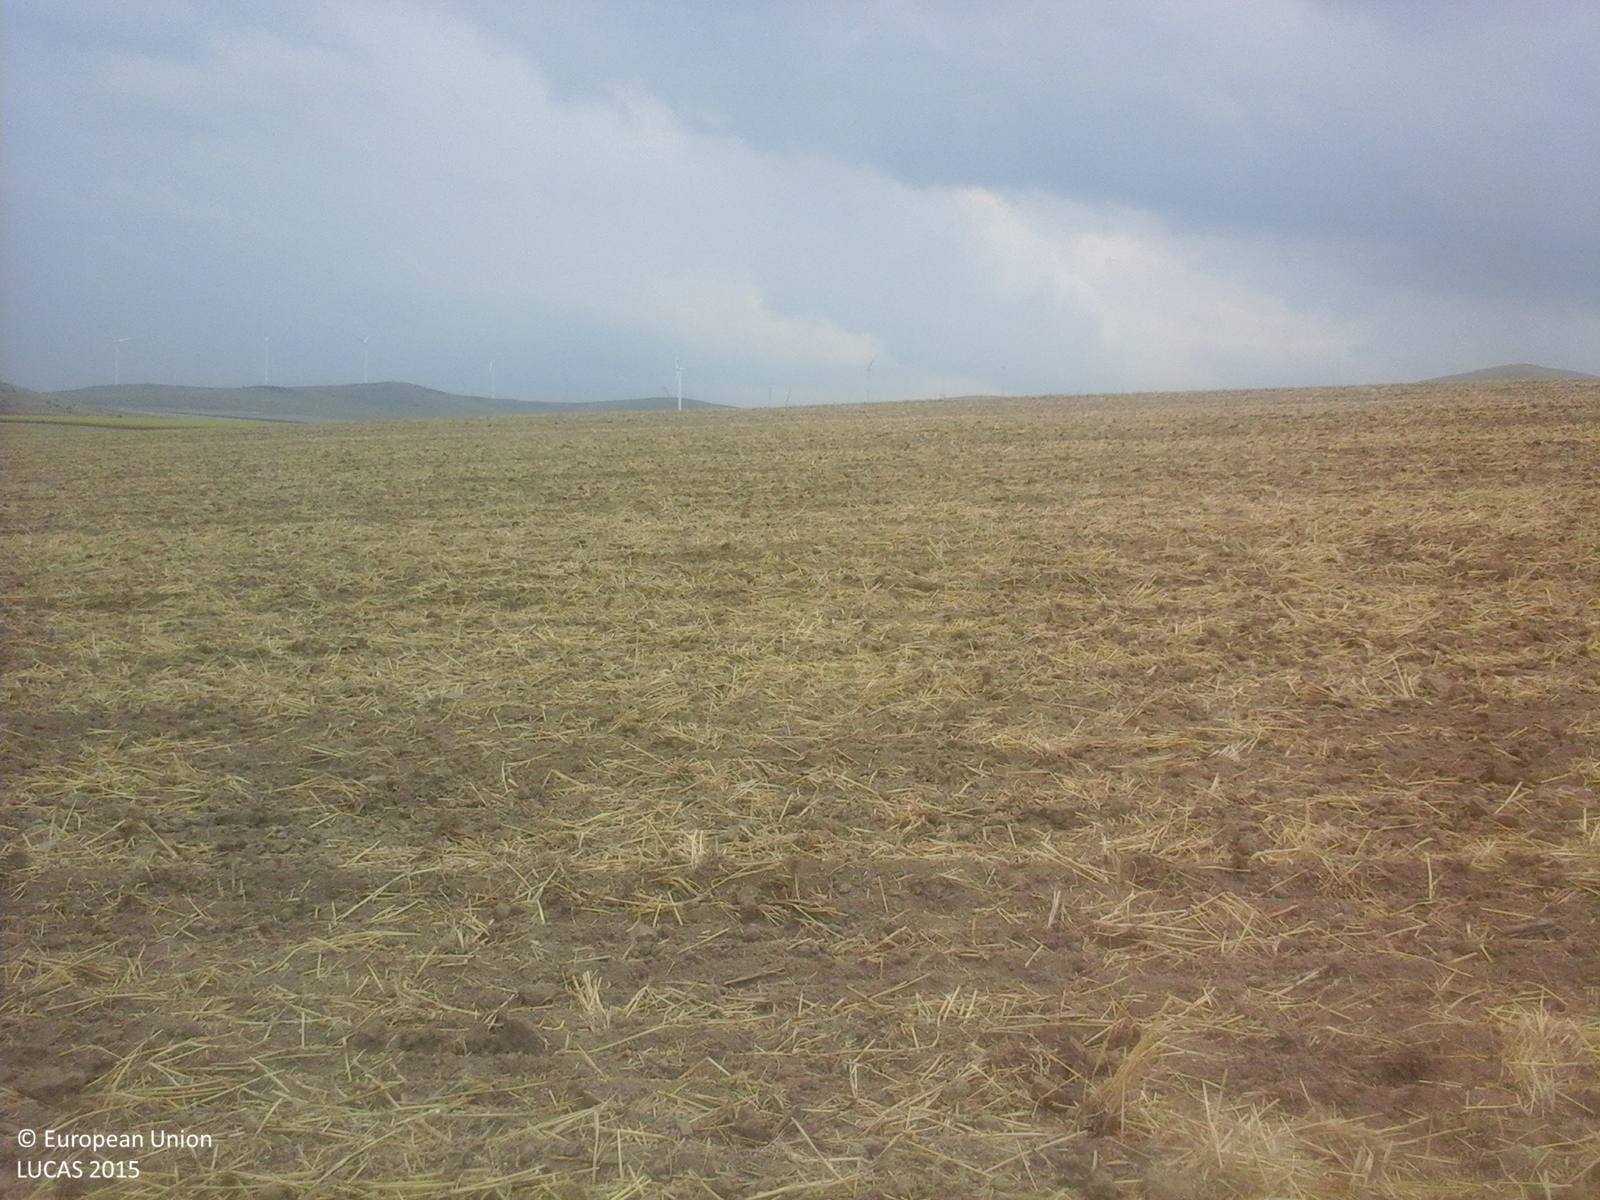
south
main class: Cropland
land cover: Common wheat
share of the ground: 10 - 25 %
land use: Agriculture (excluding fallow land and kitchen gardens)
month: July
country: RO
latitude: 44.9456
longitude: 28.6761
